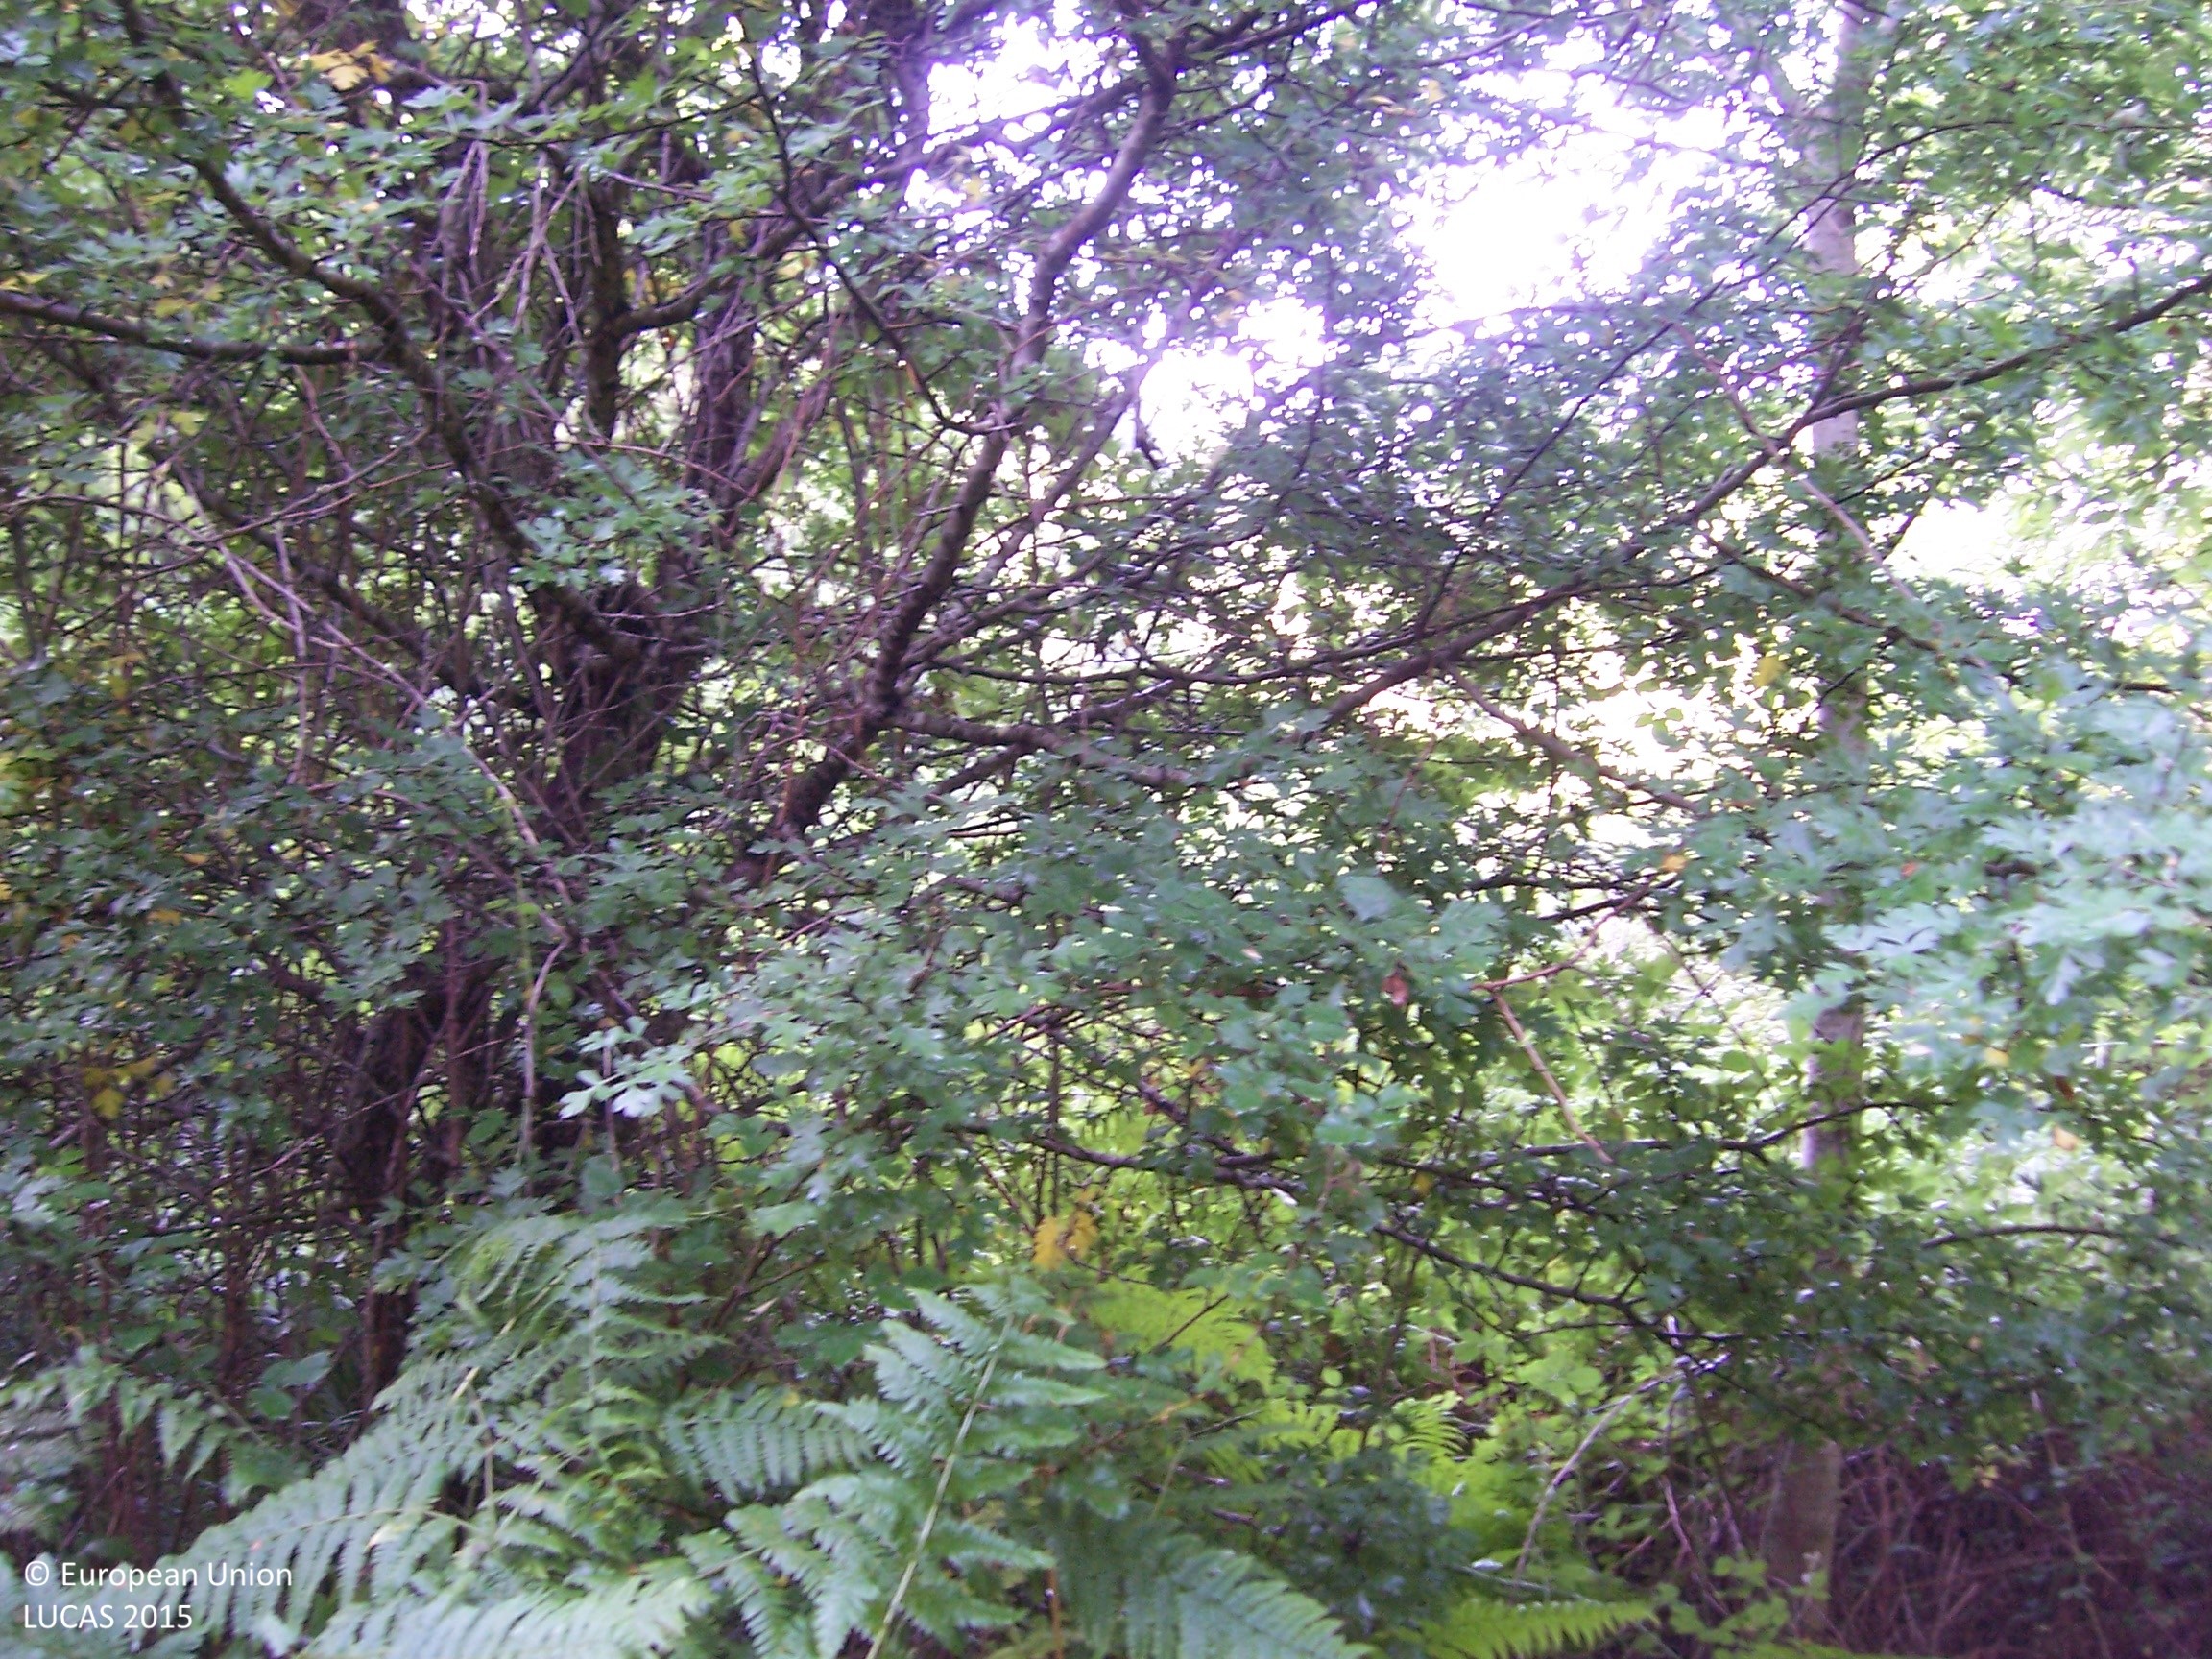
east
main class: Woodland
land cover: Broadleaved woodland
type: floodplain forest
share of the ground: > 75 %
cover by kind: broadleaved forest trees 100 %
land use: Semi-natural and natural areas not in use
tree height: > 5 m
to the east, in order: Broadleaved woodland; Tracks; Shrubland with sparse tree cover; Tracks; Shrubland with sparse tree cover; Tracks; Grassland without tree/shrub cover; Grassland with sparse tree/shrub cover
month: July
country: ES
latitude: 42.9979
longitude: -1.5083
